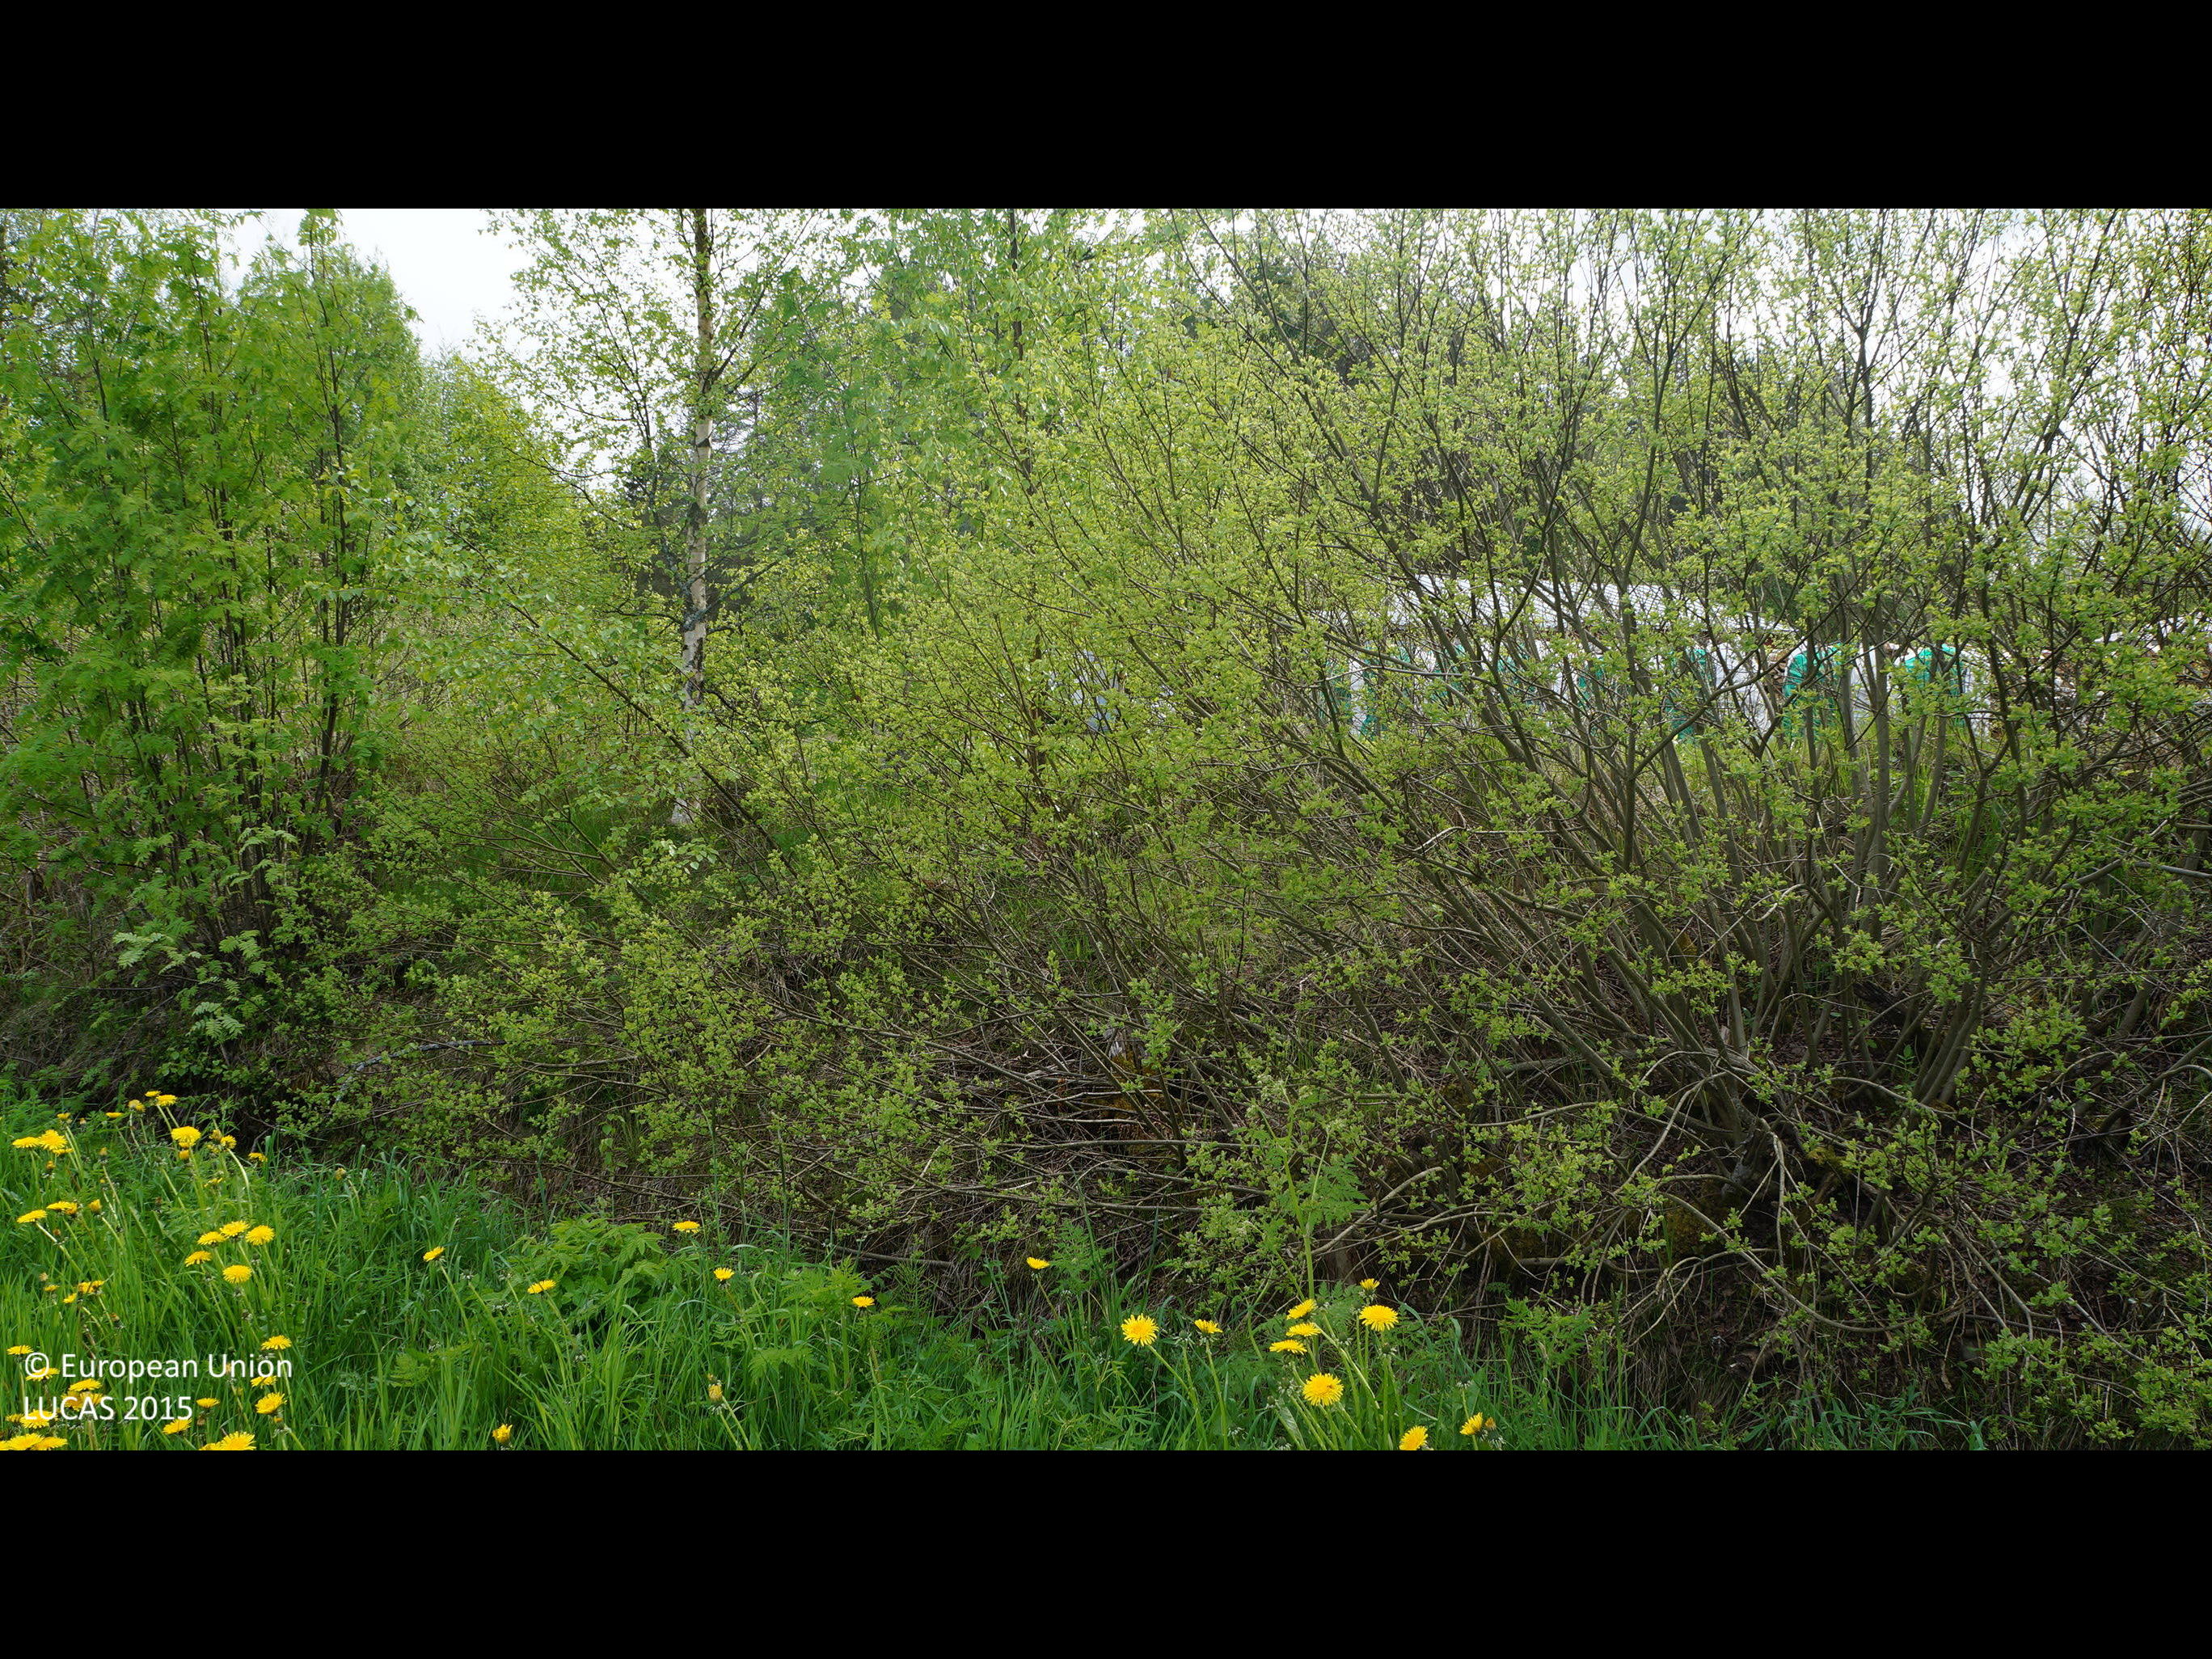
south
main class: Cropland
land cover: Temporary grasslands
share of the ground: > 75 %
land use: Agriculture (excluding fallow land and kitchen gardens)
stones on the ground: < 10 %
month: June
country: FI
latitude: 63.7059
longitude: 23.3099
